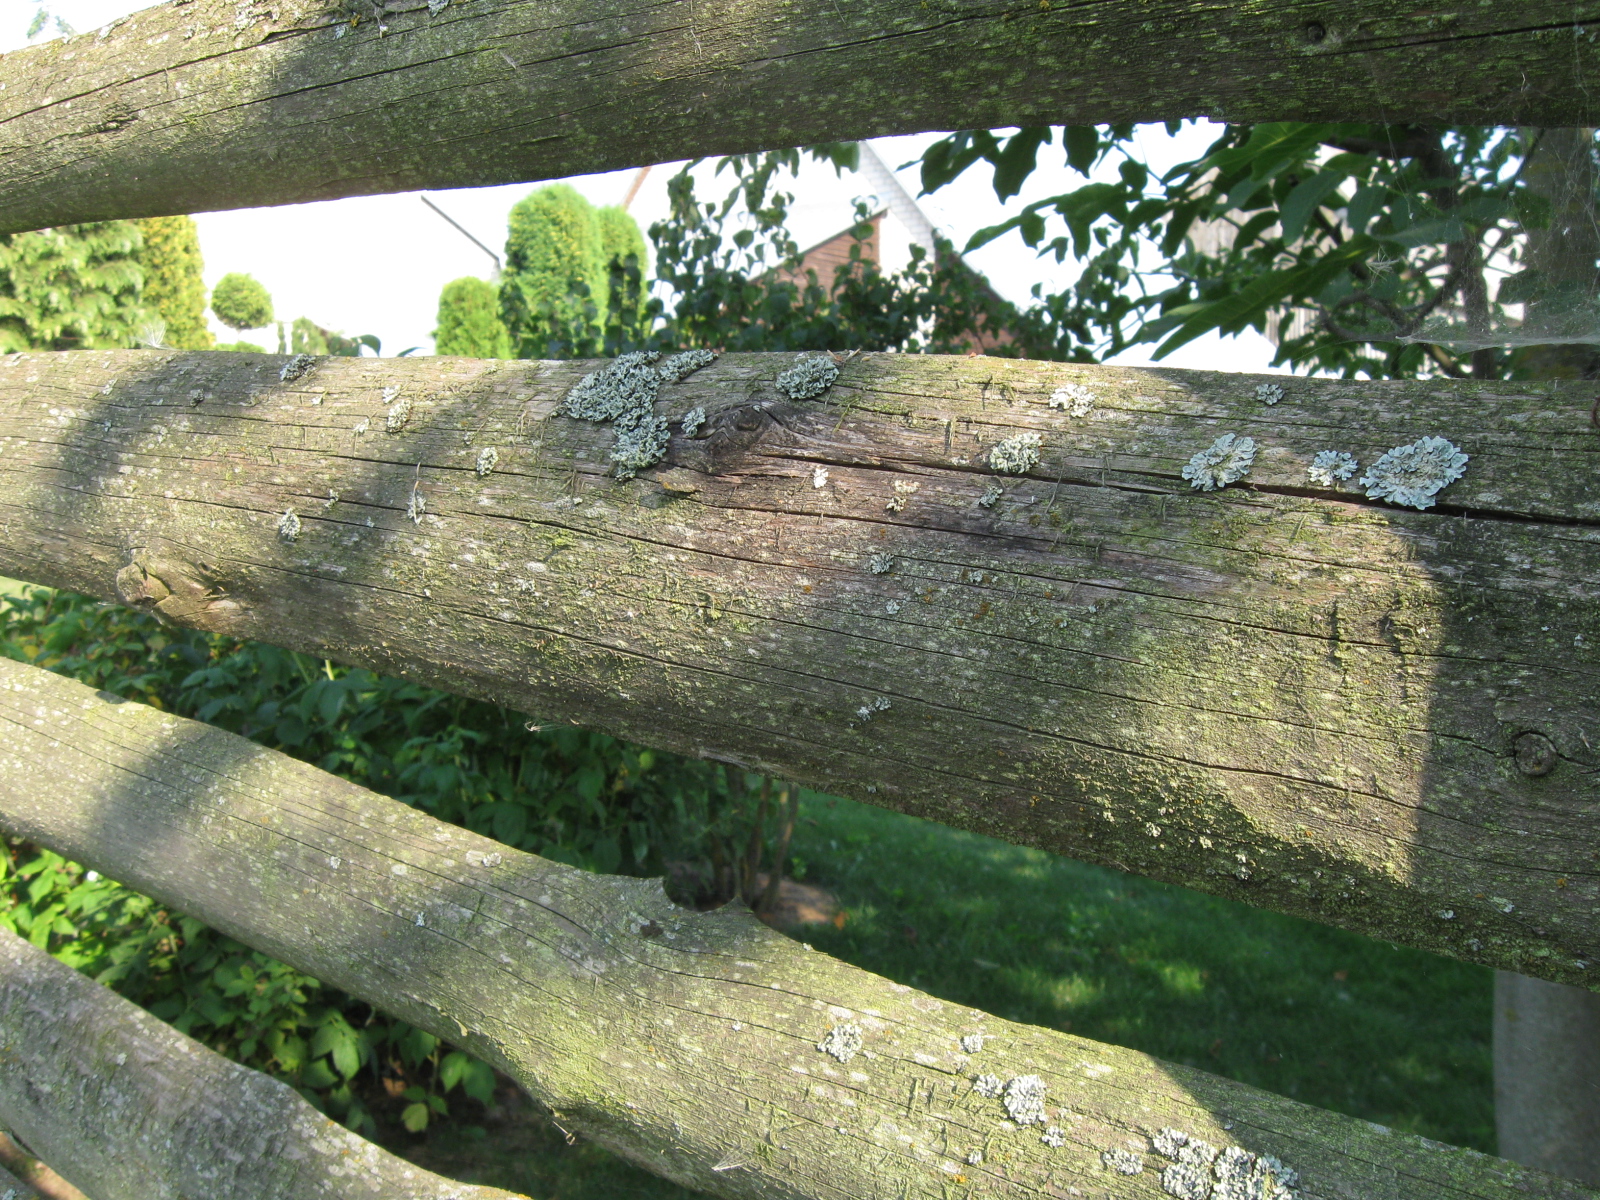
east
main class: Cropland
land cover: Apple fruit
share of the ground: 10 - 25 %
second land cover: Grassland without tree/shrub cover
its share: > 75 %
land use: Kitchen garden
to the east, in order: Apple fruit; Grassland without tree/shrub cover; Artificial constructions in urban areas; Spontaneously vegetated surfaces; Tracks; Grass margins; Common wheat; Grass margins; Rape and turnip rape
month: August
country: LT
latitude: 54.4374
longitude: 23.2597
